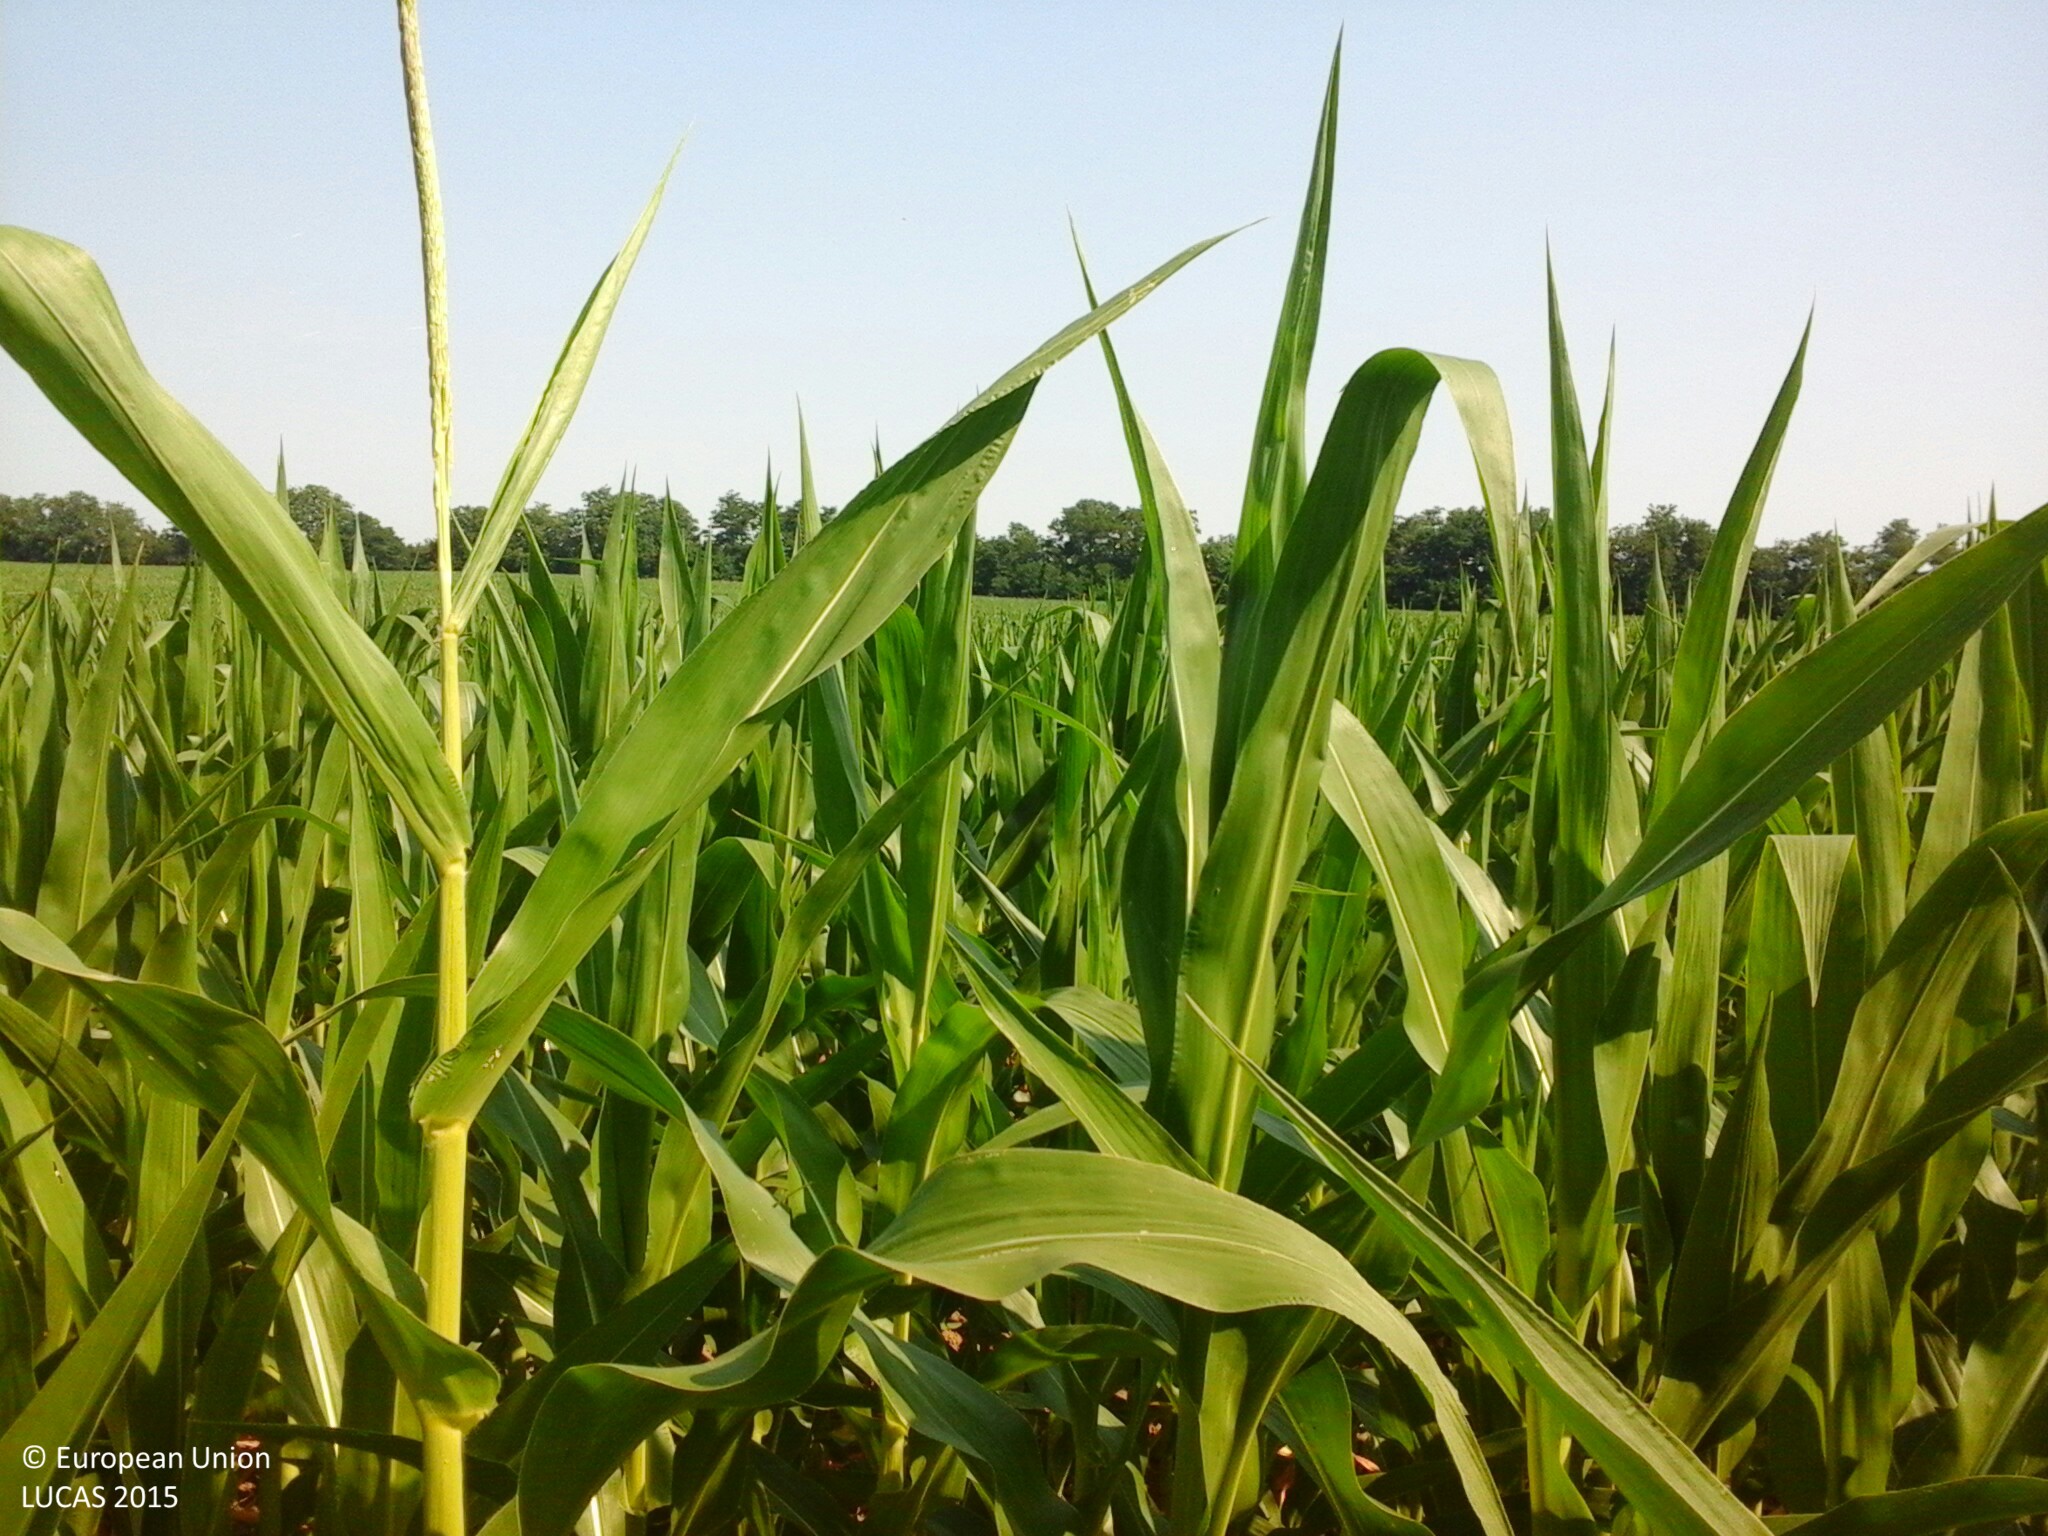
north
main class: Cropland
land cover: Maize
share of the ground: > 75 %
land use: Agriculture (excluding fallow land and kitchen gardens)
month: July
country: HU
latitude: 48.1473
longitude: 22.1653
